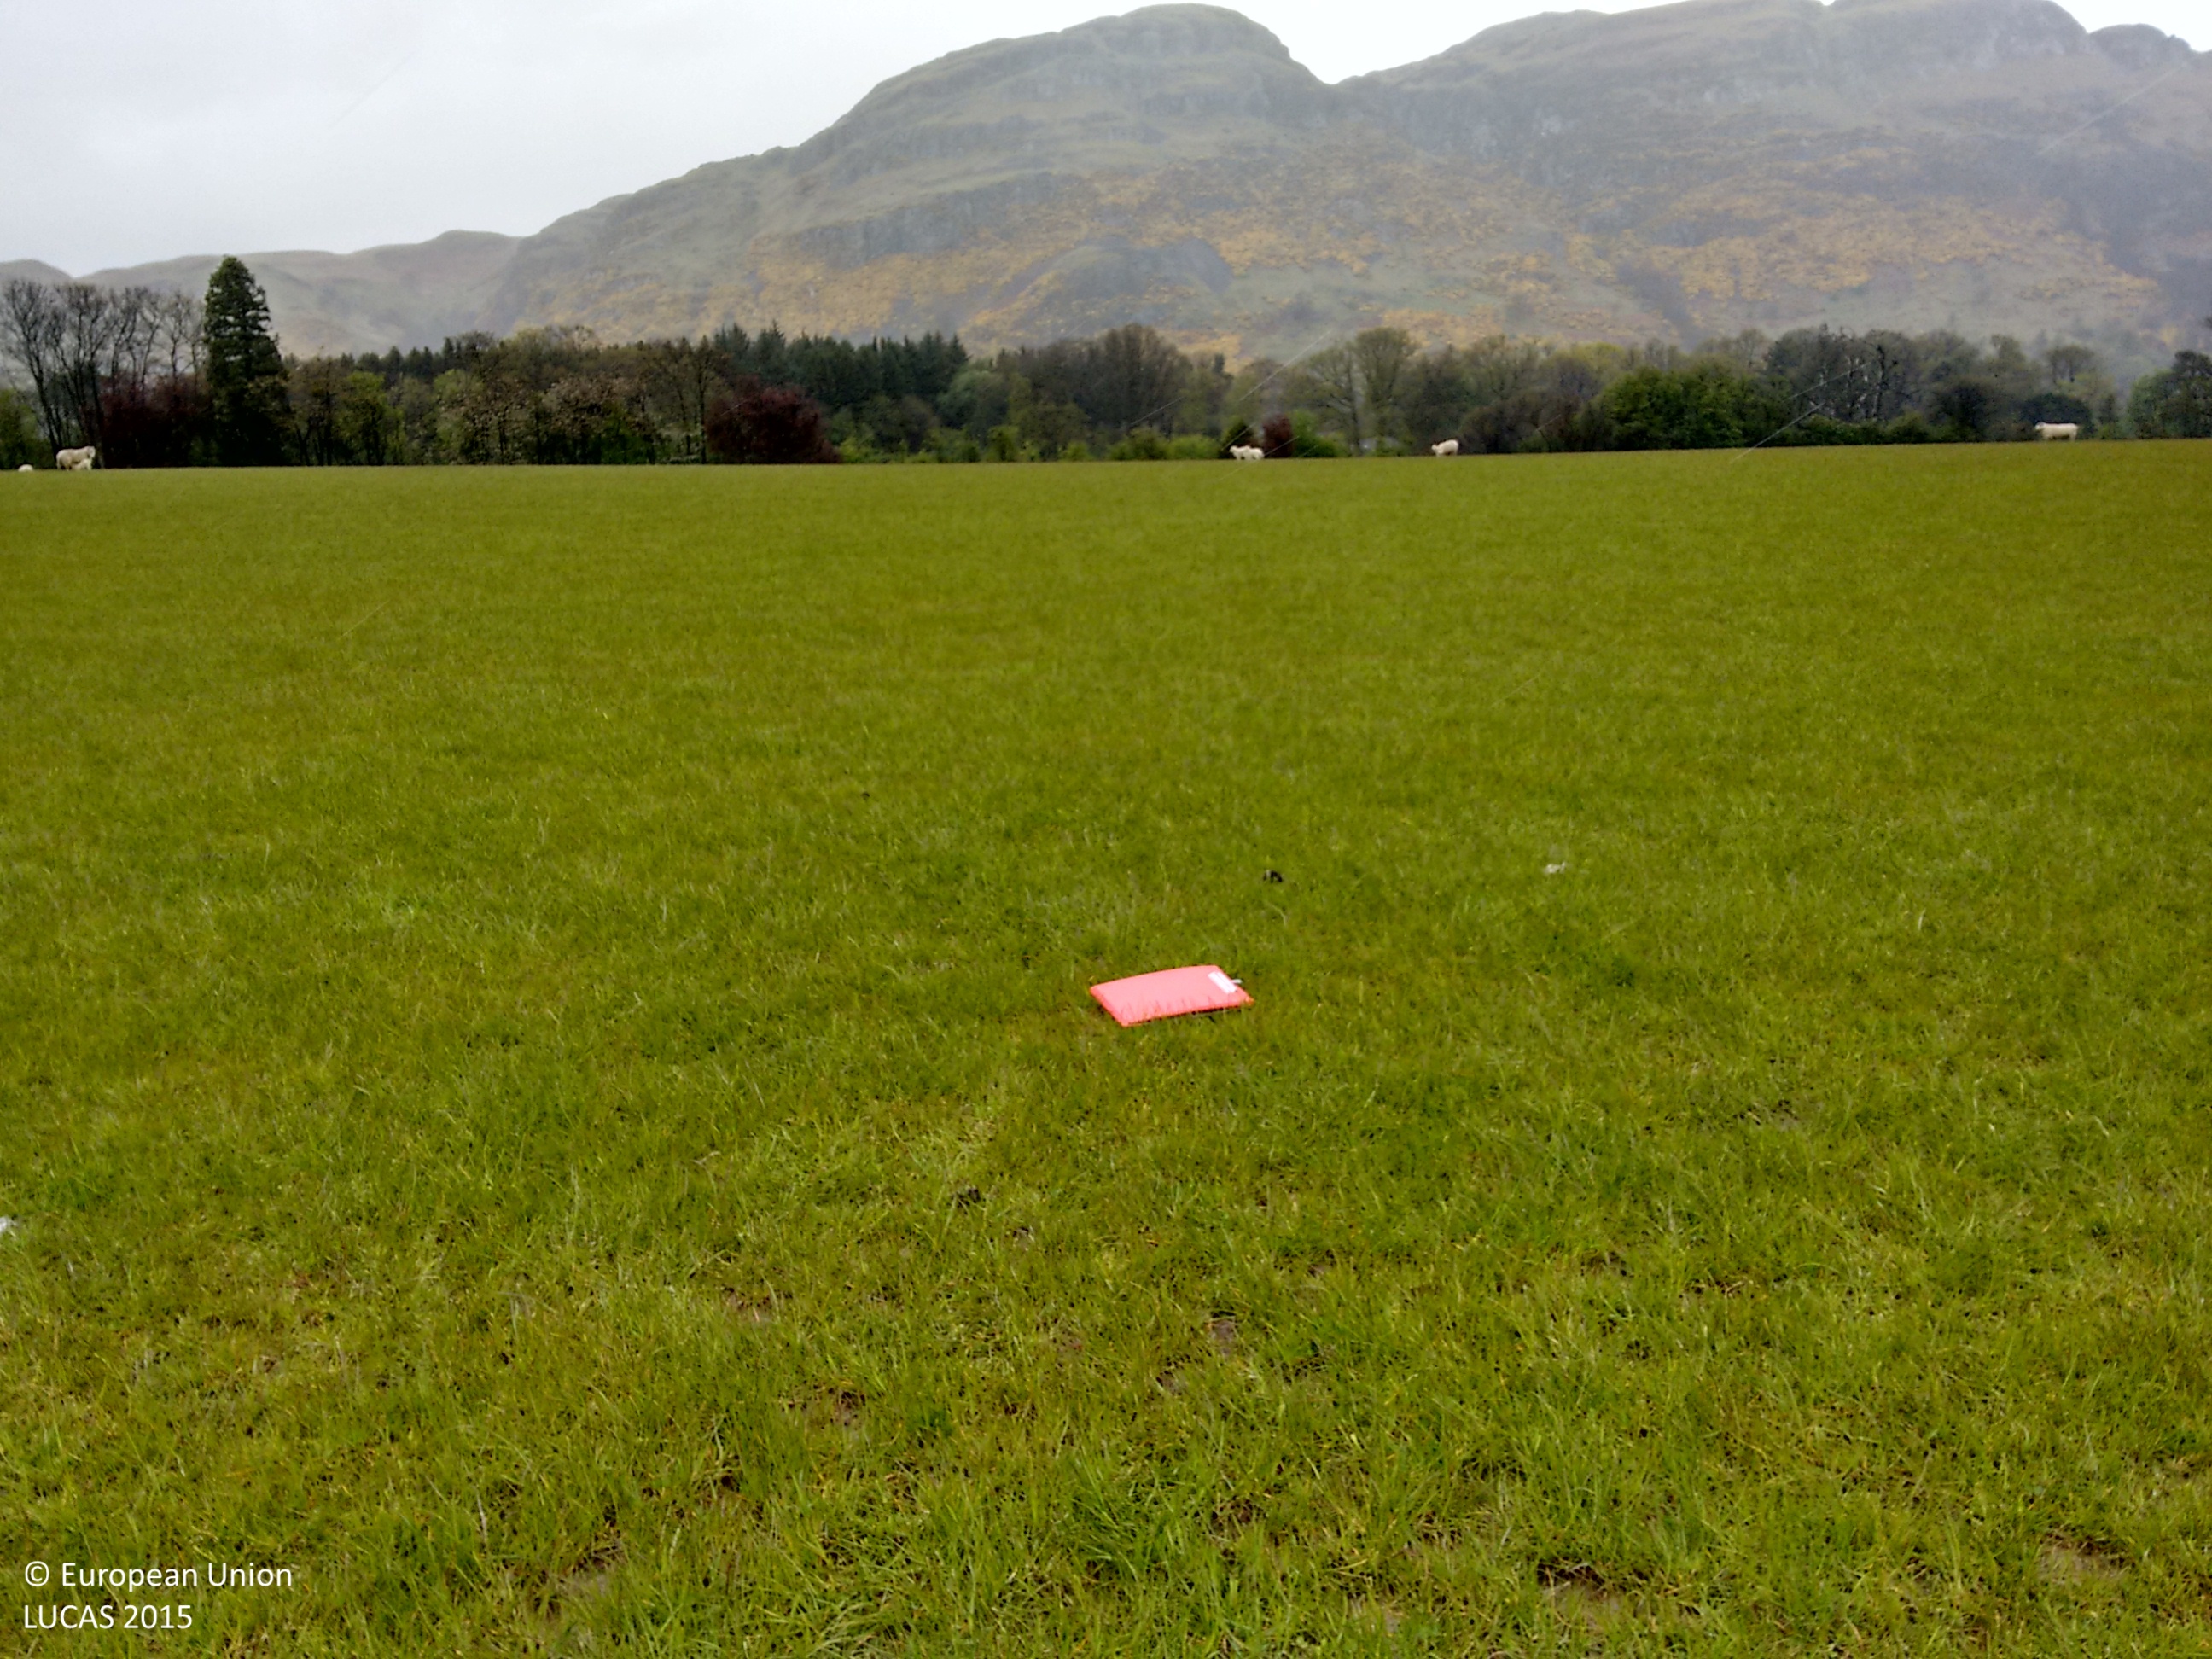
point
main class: Grassland
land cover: Grassland without tree/shrub cover
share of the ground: > 75 %
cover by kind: herbaceous plants 100 %
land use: Agriculture (excluding fallow land and kitchen gardens)
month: May
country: GB
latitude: 56.1416
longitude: -3.8764
